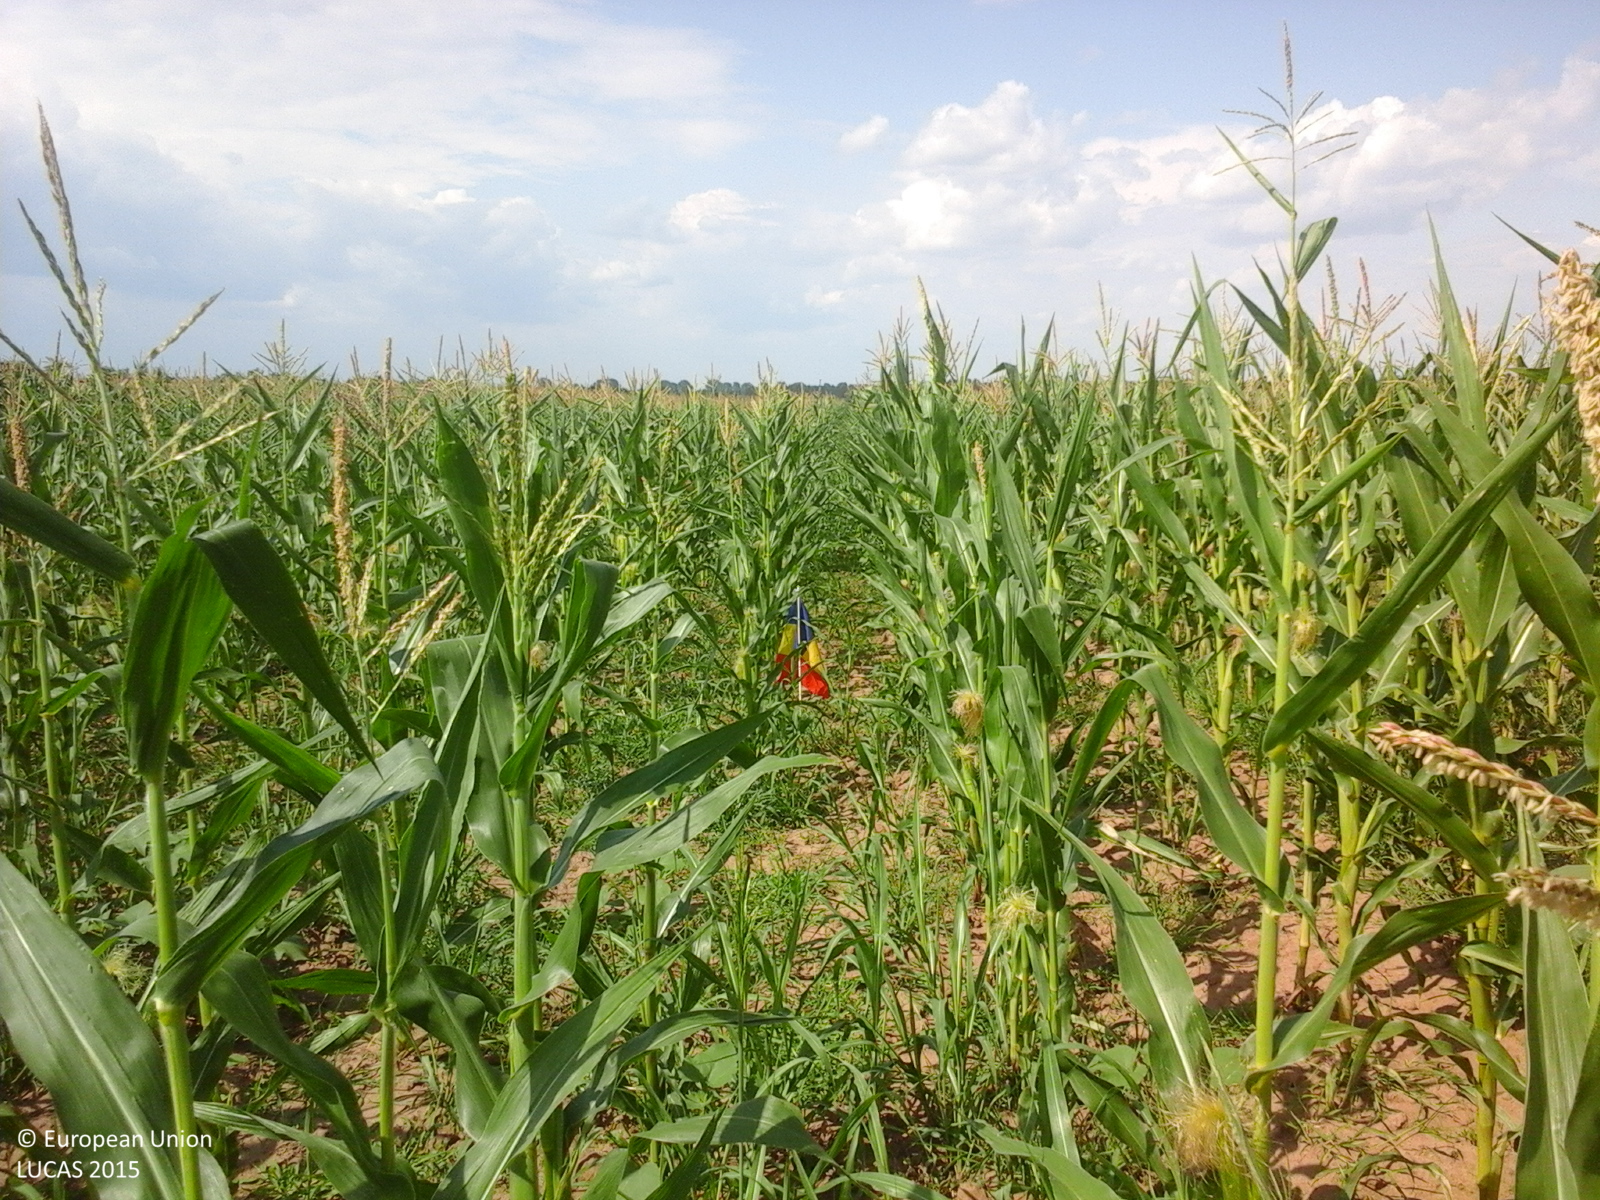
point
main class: Cropland
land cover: Maize
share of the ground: > 75 %
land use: Agriculture (excluding fallow land and kitchen gardens)
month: July
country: RO
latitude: 43.8605
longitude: 24.0794
